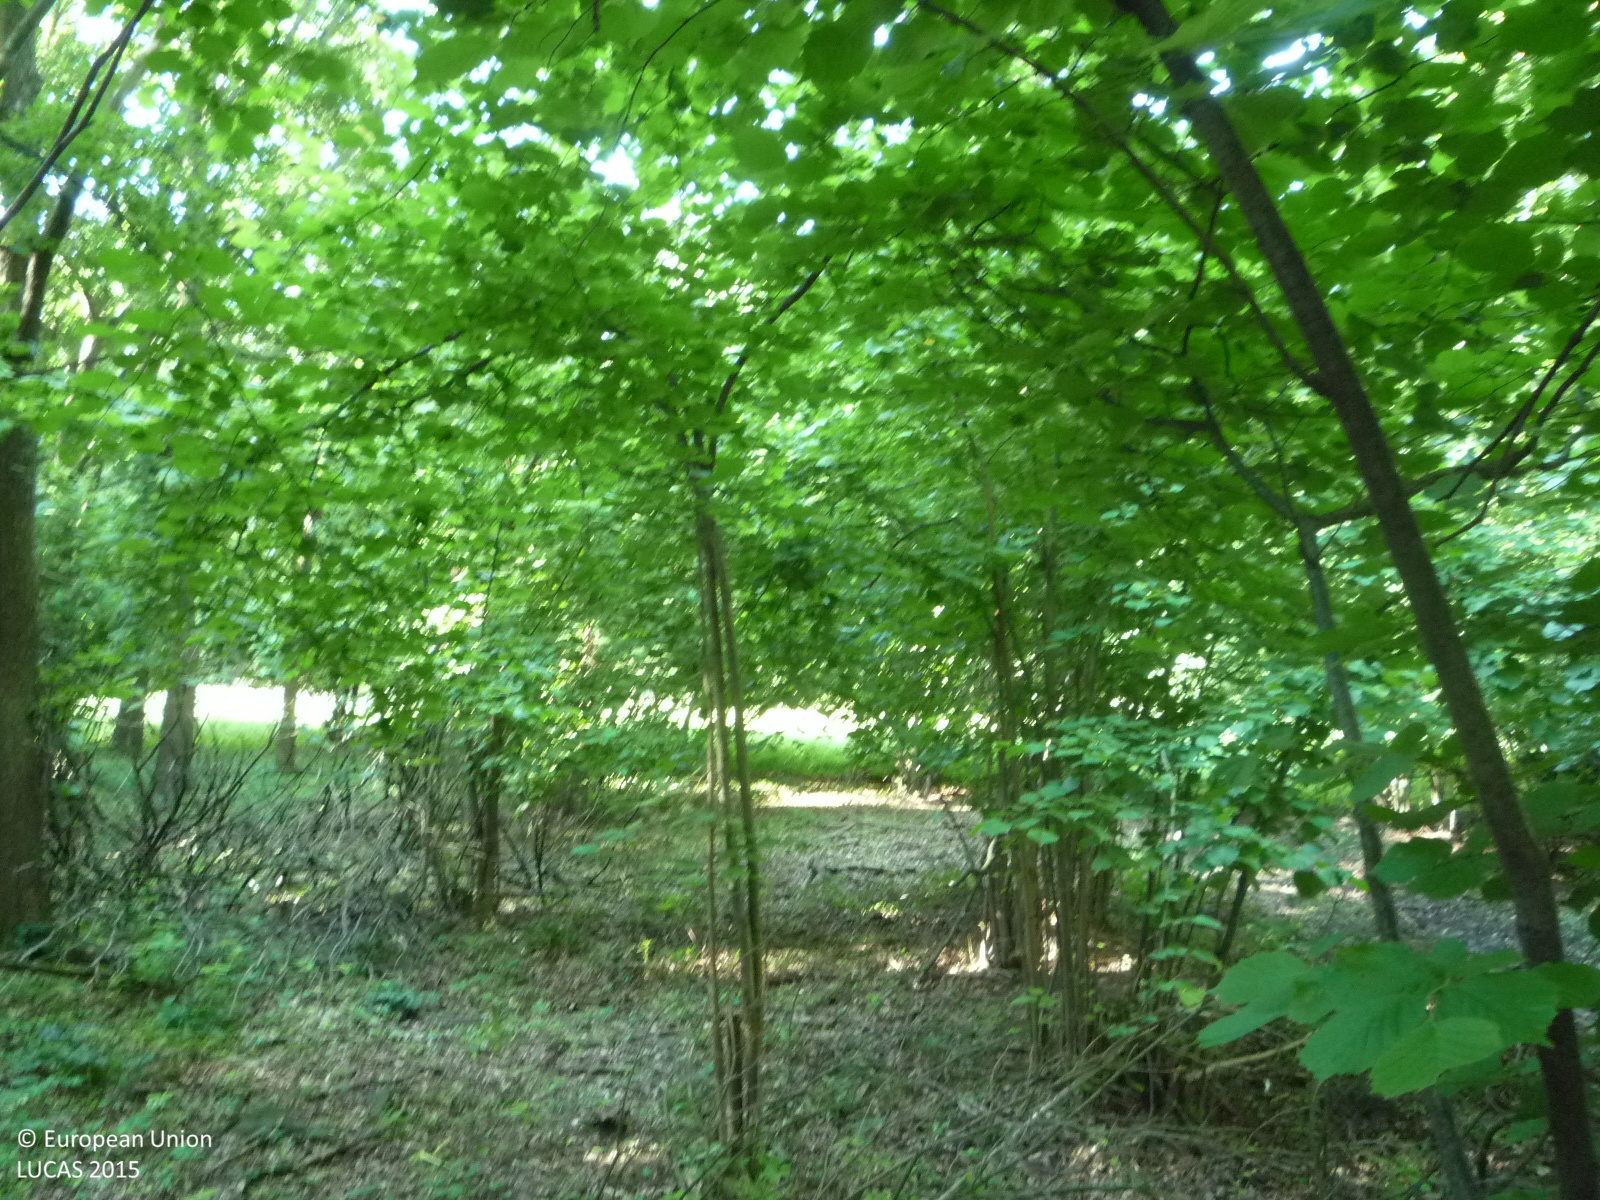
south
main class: Woodland
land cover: Broadleaved woodland
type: mesophytic deciduous forest
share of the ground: > 75 %
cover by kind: broadleaved forest trees 95 %, shrubs 5 %
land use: Forestry
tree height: > 5 m
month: July
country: CZ
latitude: 50.5323
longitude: 13.8805
